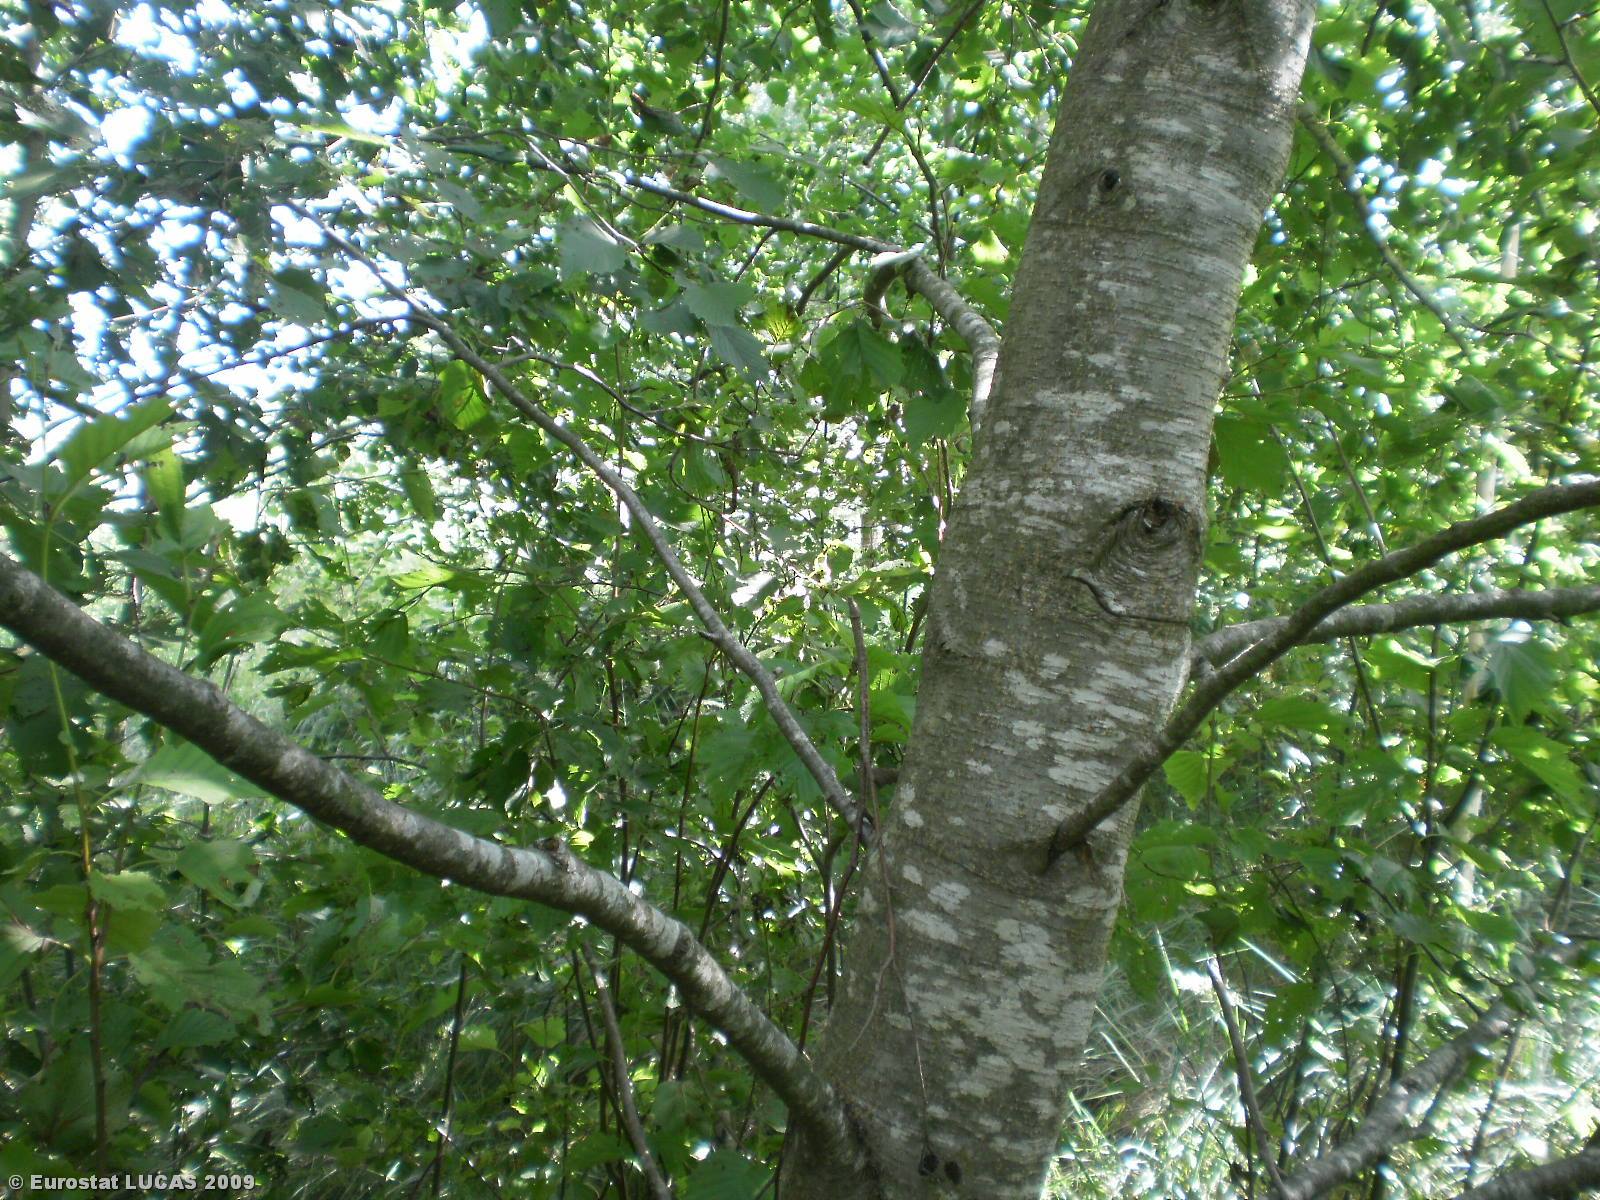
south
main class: Woodland
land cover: Broadleaved woodland
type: non-riverine alder, birch or aspen forest
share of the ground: > 75 %
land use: Forestry
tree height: > 5 m
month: July
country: LT
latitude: 56.1008
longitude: 25.3425
